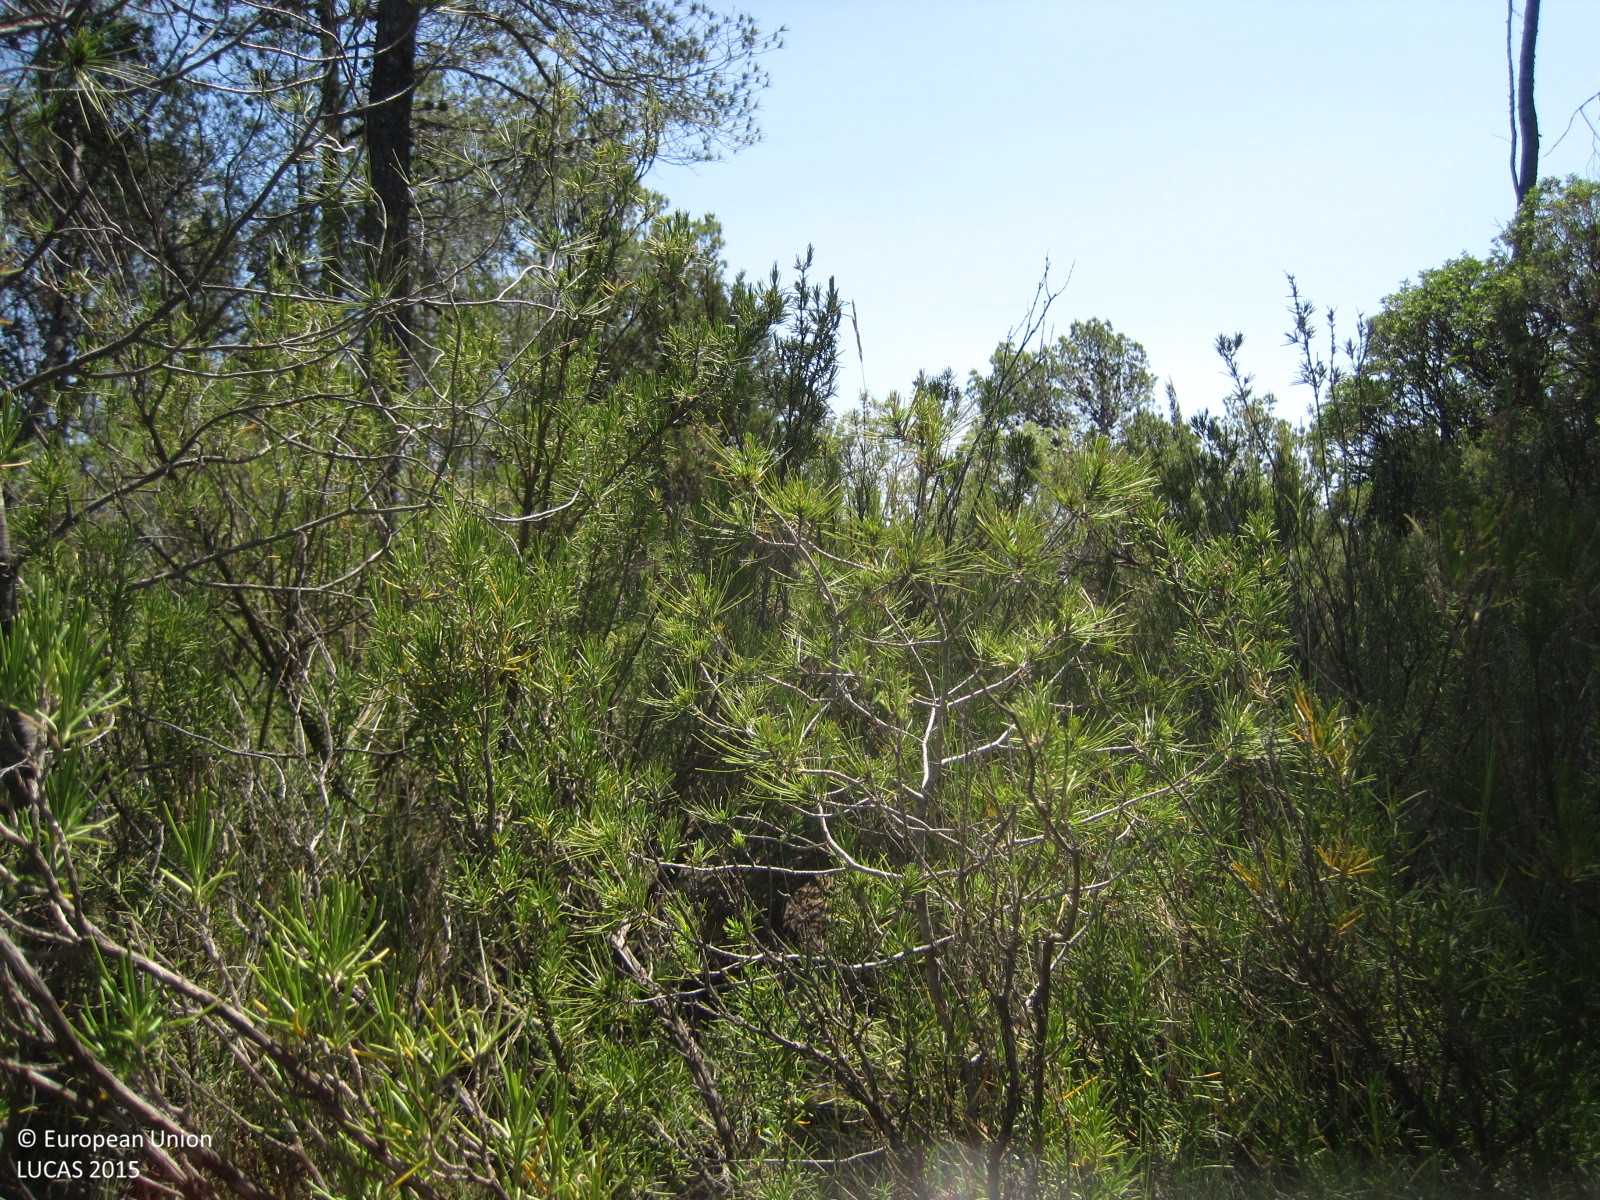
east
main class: Woodland
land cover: Pine dominated coniferous woodland
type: coniferous forest of the mediterranean region
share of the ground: 25 - 50 %
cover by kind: coniferous forest trees 40 %, shrubs 30 %, herbaceous plants 20 %, consolidated bare surface 10 %
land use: Forestry
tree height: > 5 m
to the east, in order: Pine dominated coniferous woodland; Dry stone walls; Pine dominated coniferous woodland
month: June
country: ES
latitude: 39.7931
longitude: -1.1576
